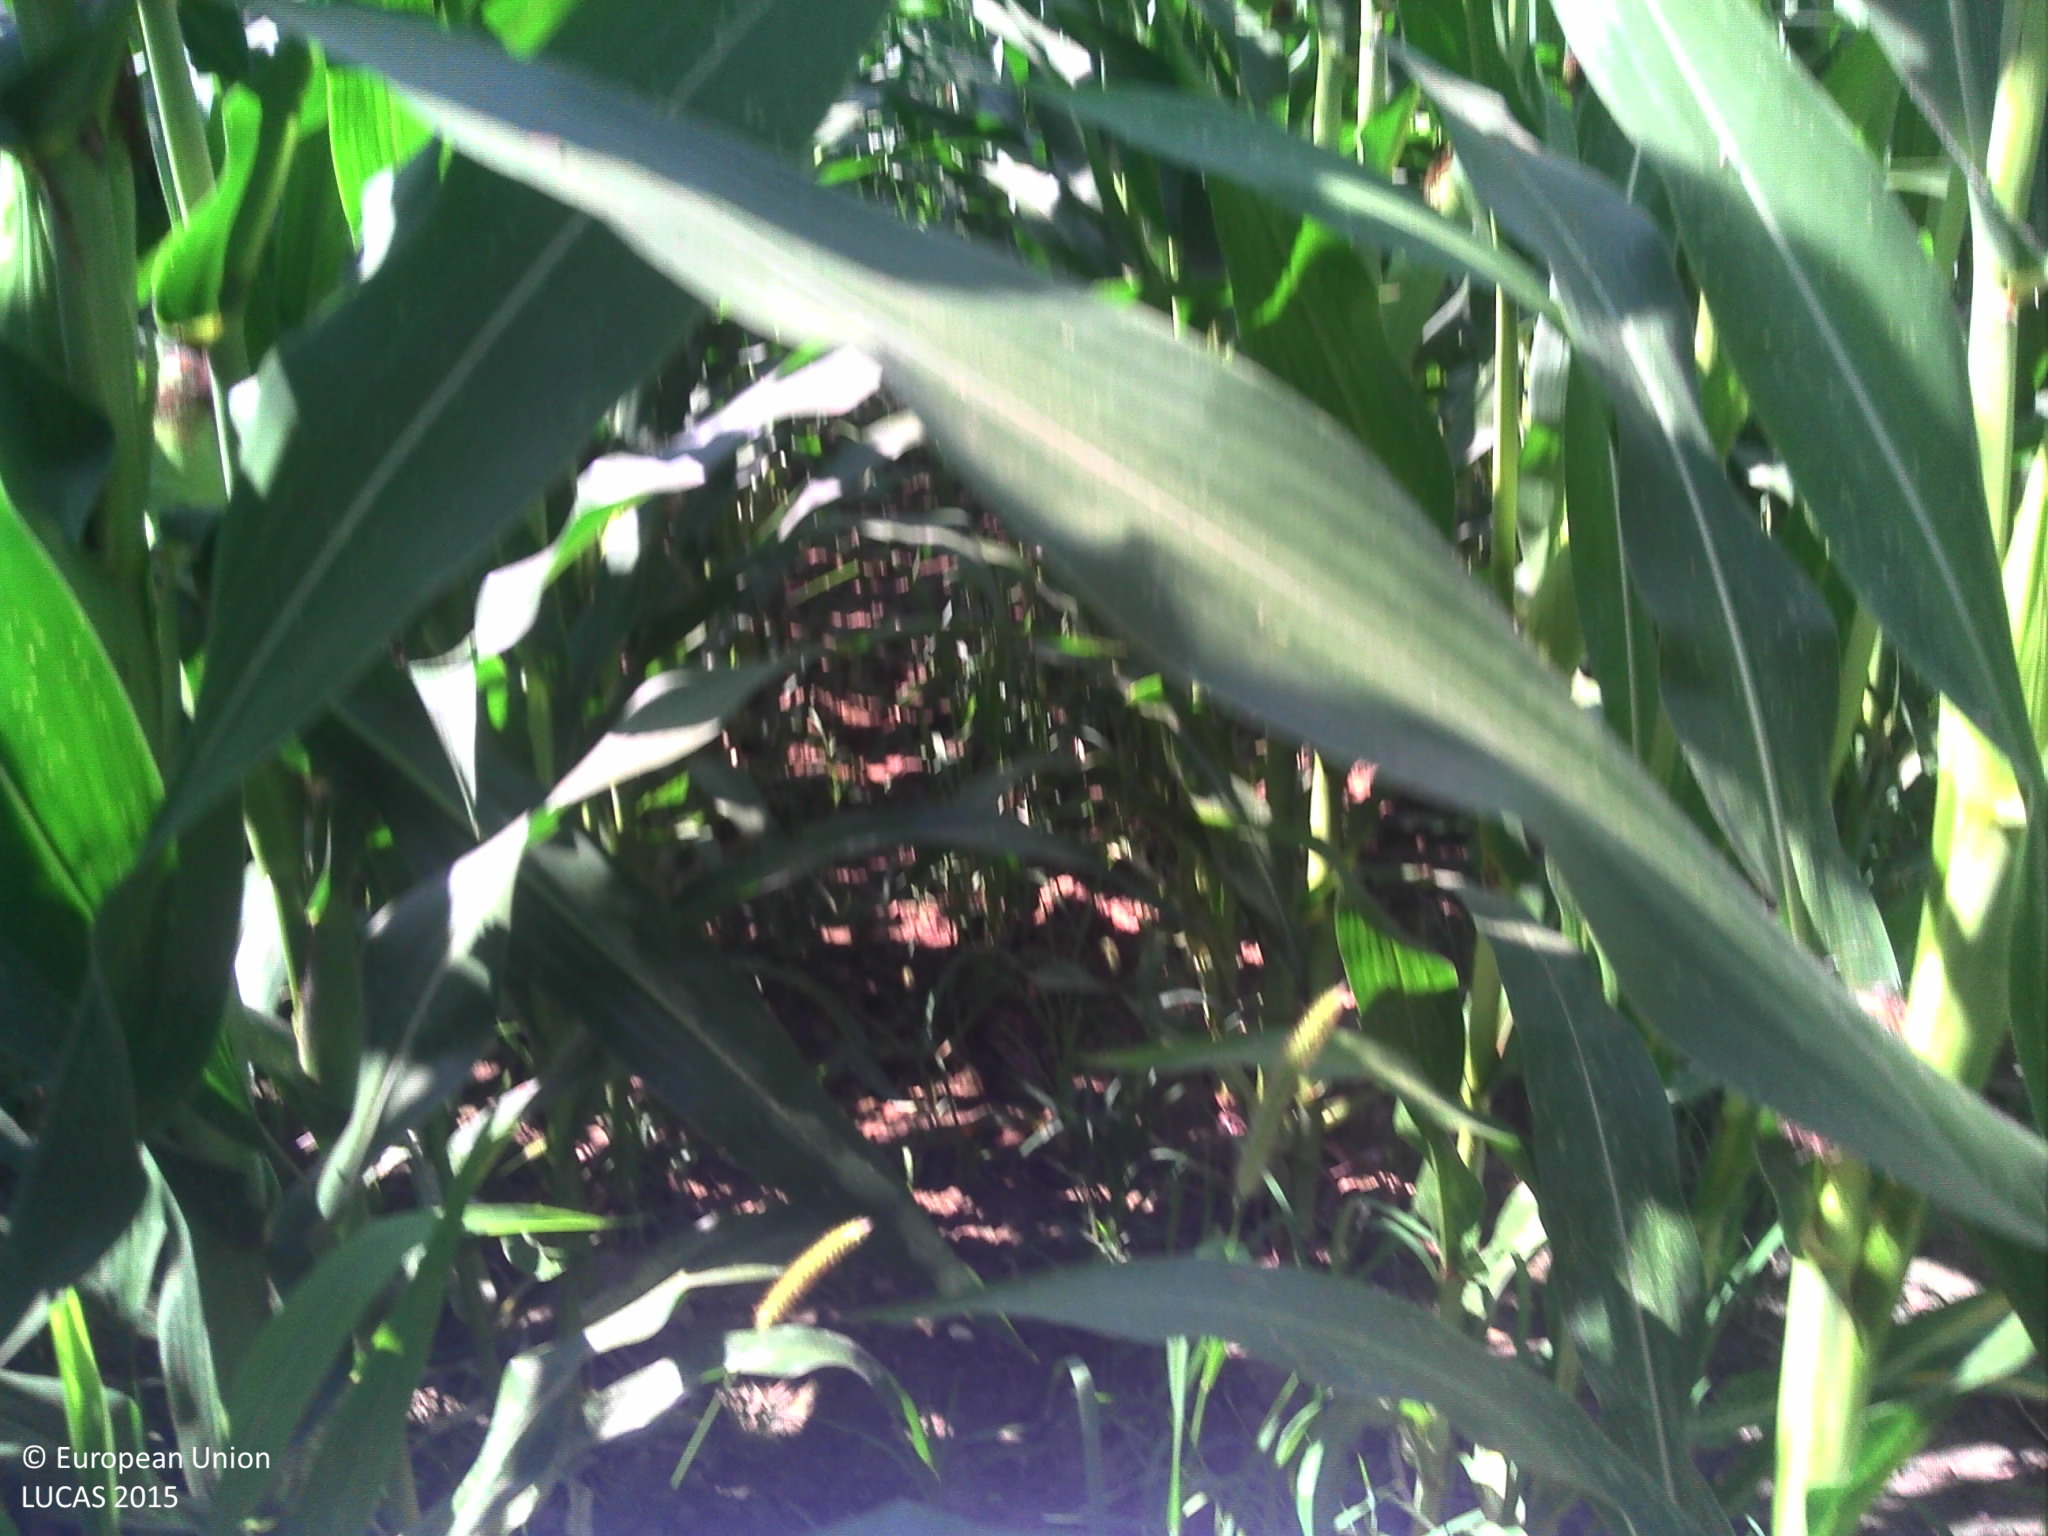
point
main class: Cropland
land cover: Maize
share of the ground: > 75 %
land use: Agriculture (excluding fallow land and kitchen gardens)
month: August
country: FR
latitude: 44.0350
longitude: 1.2521
